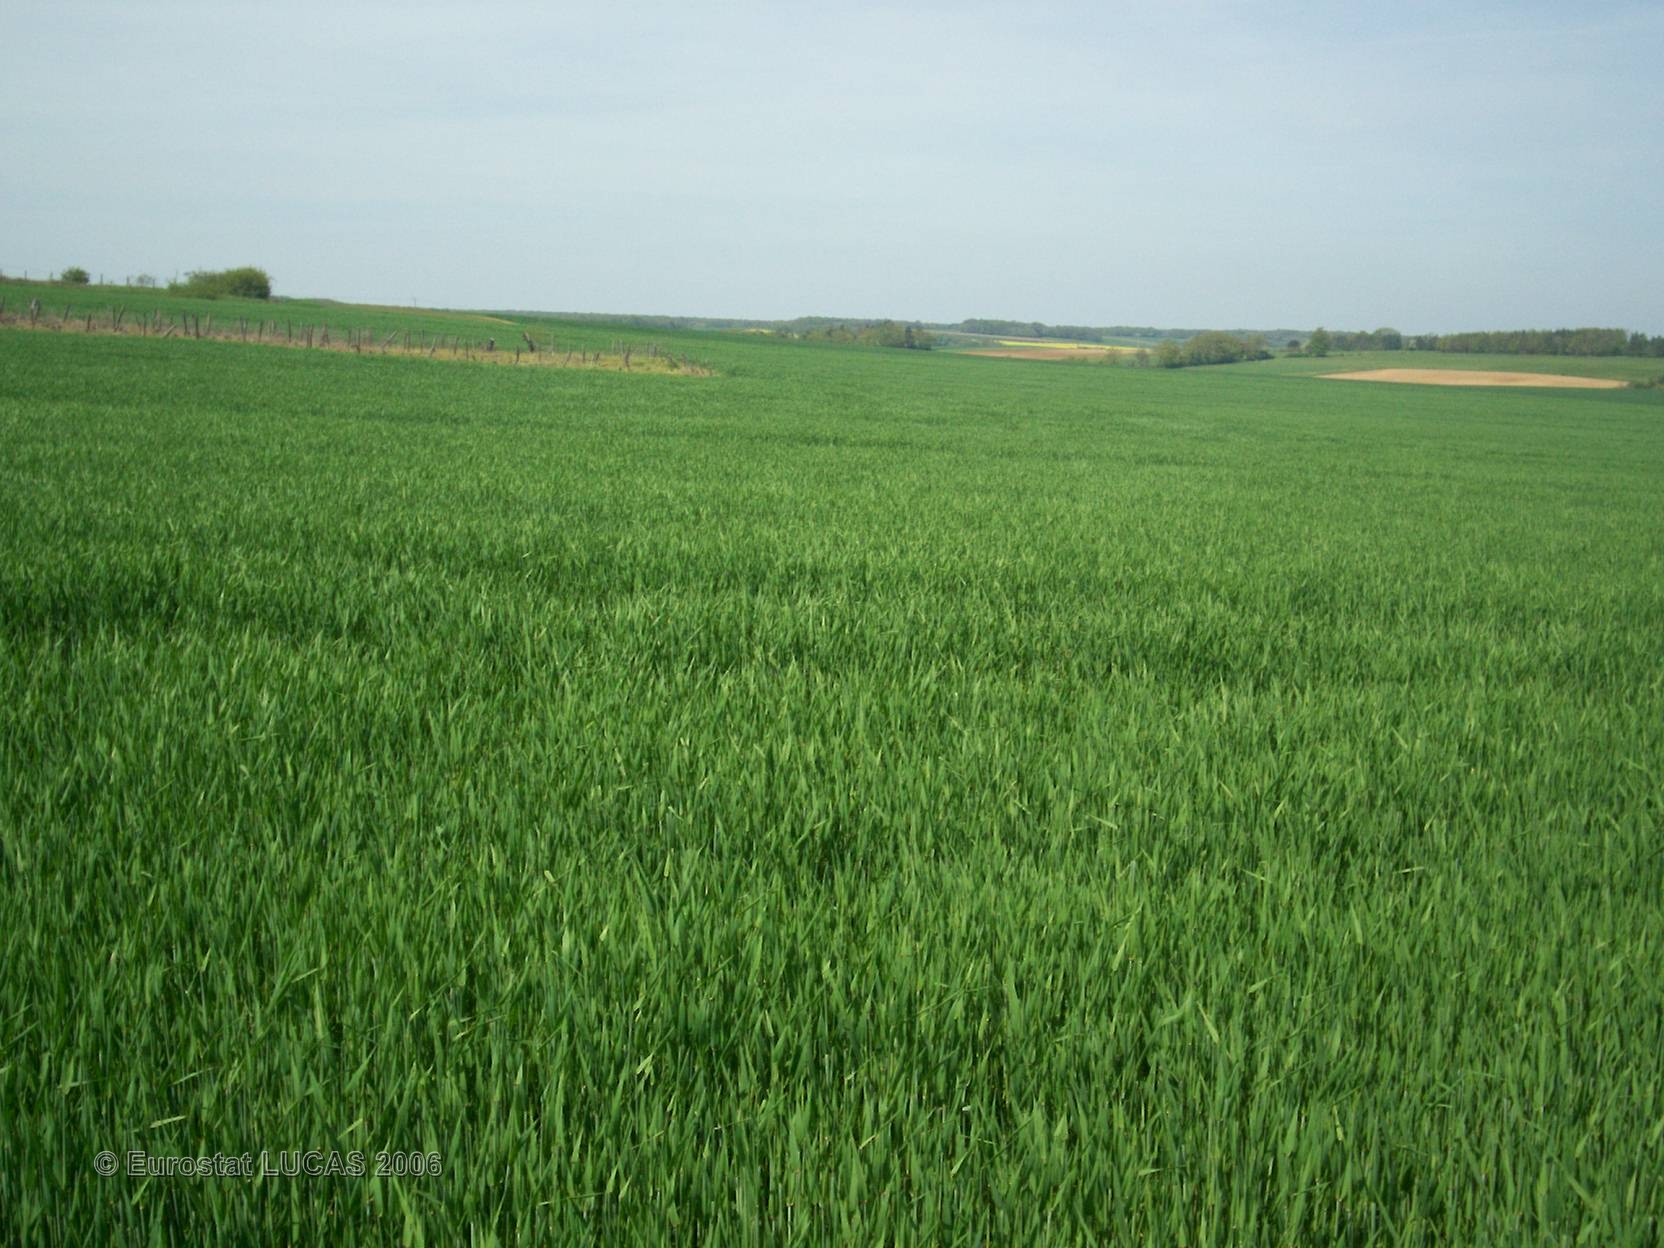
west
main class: Cropland
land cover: Barley
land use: Agriculture (excluding fallow land and kitchen gardens)
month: May
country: FR
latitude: 47.9719
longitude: 4.0359
